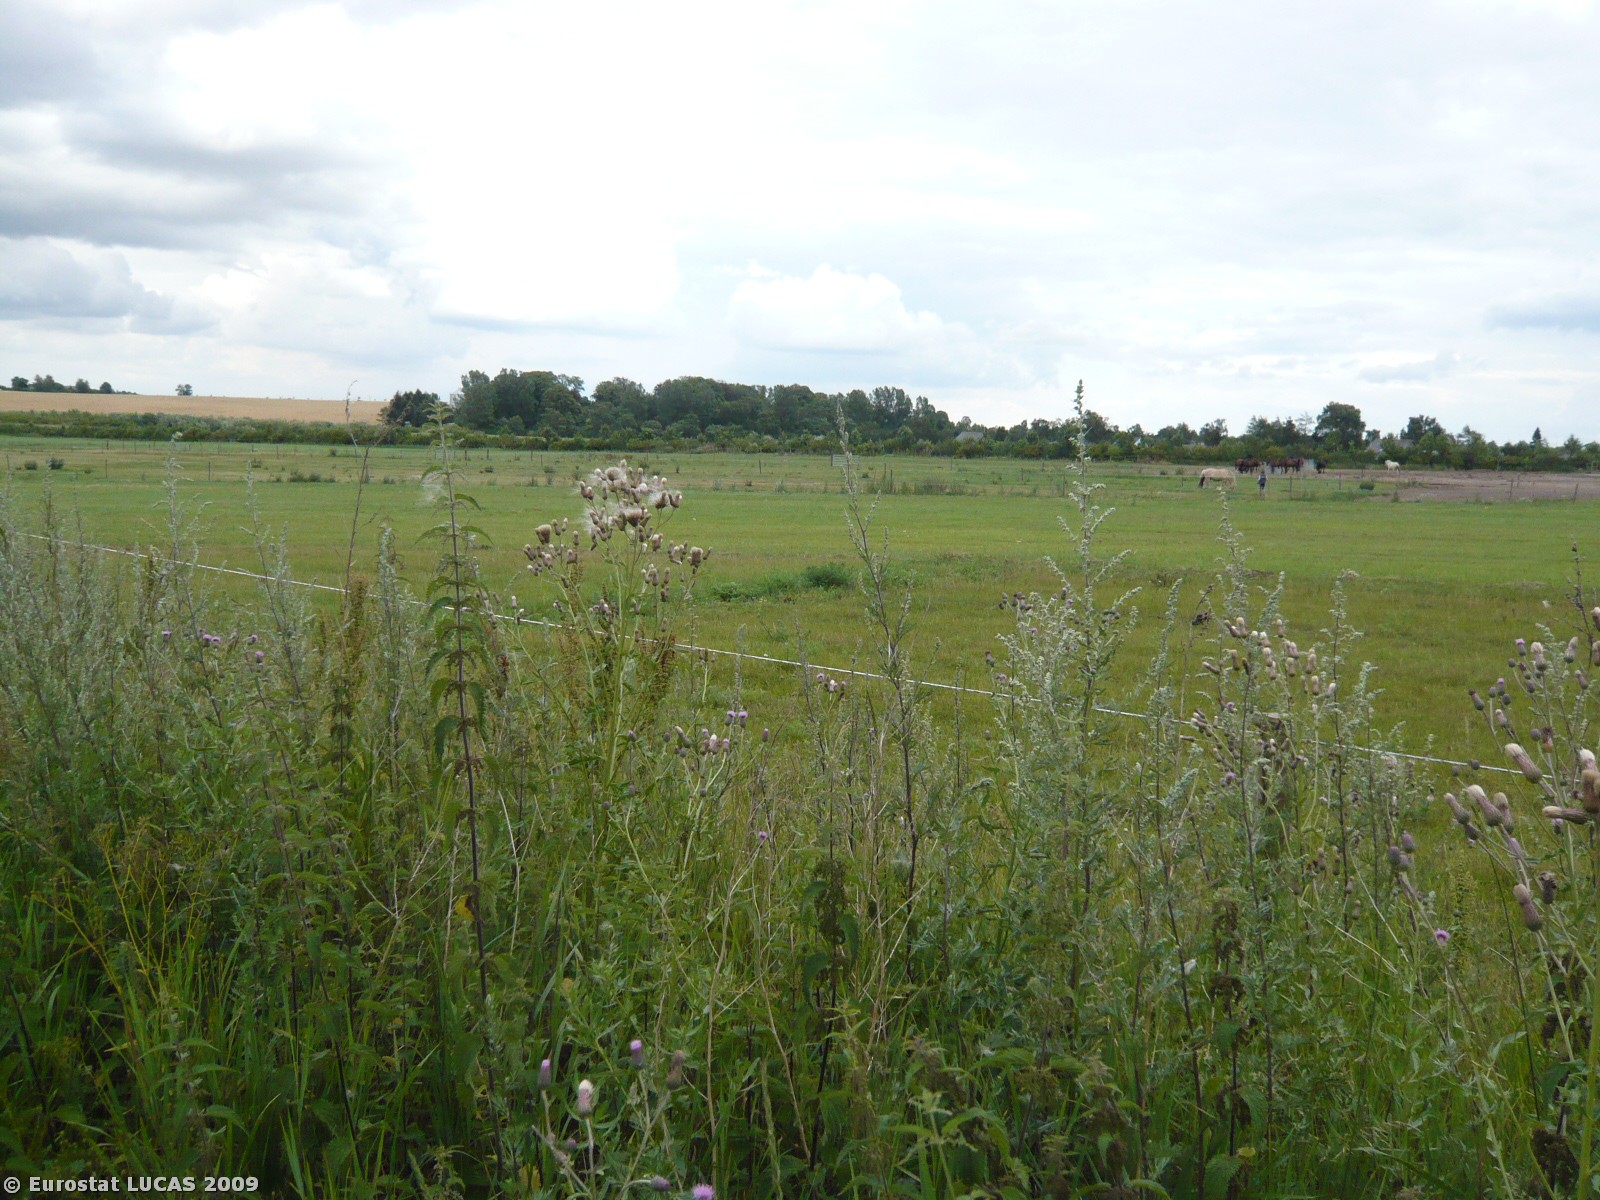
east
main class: Grassland
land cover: Grassland without tree/shrub cover
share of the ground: > 75 %
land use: Agriculture (excluding fallow land and kitchen gardens)
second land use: Amenities, museums, leisure
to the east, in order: Grassland without tree/shrub cover; Fences; Shrubland with sparse tree cover; Fences; Grassland without tree/shrub cover; Fences; Grassland without tree/shrub cover
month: July
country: DK
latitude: 55.5607
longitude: 12.0119
